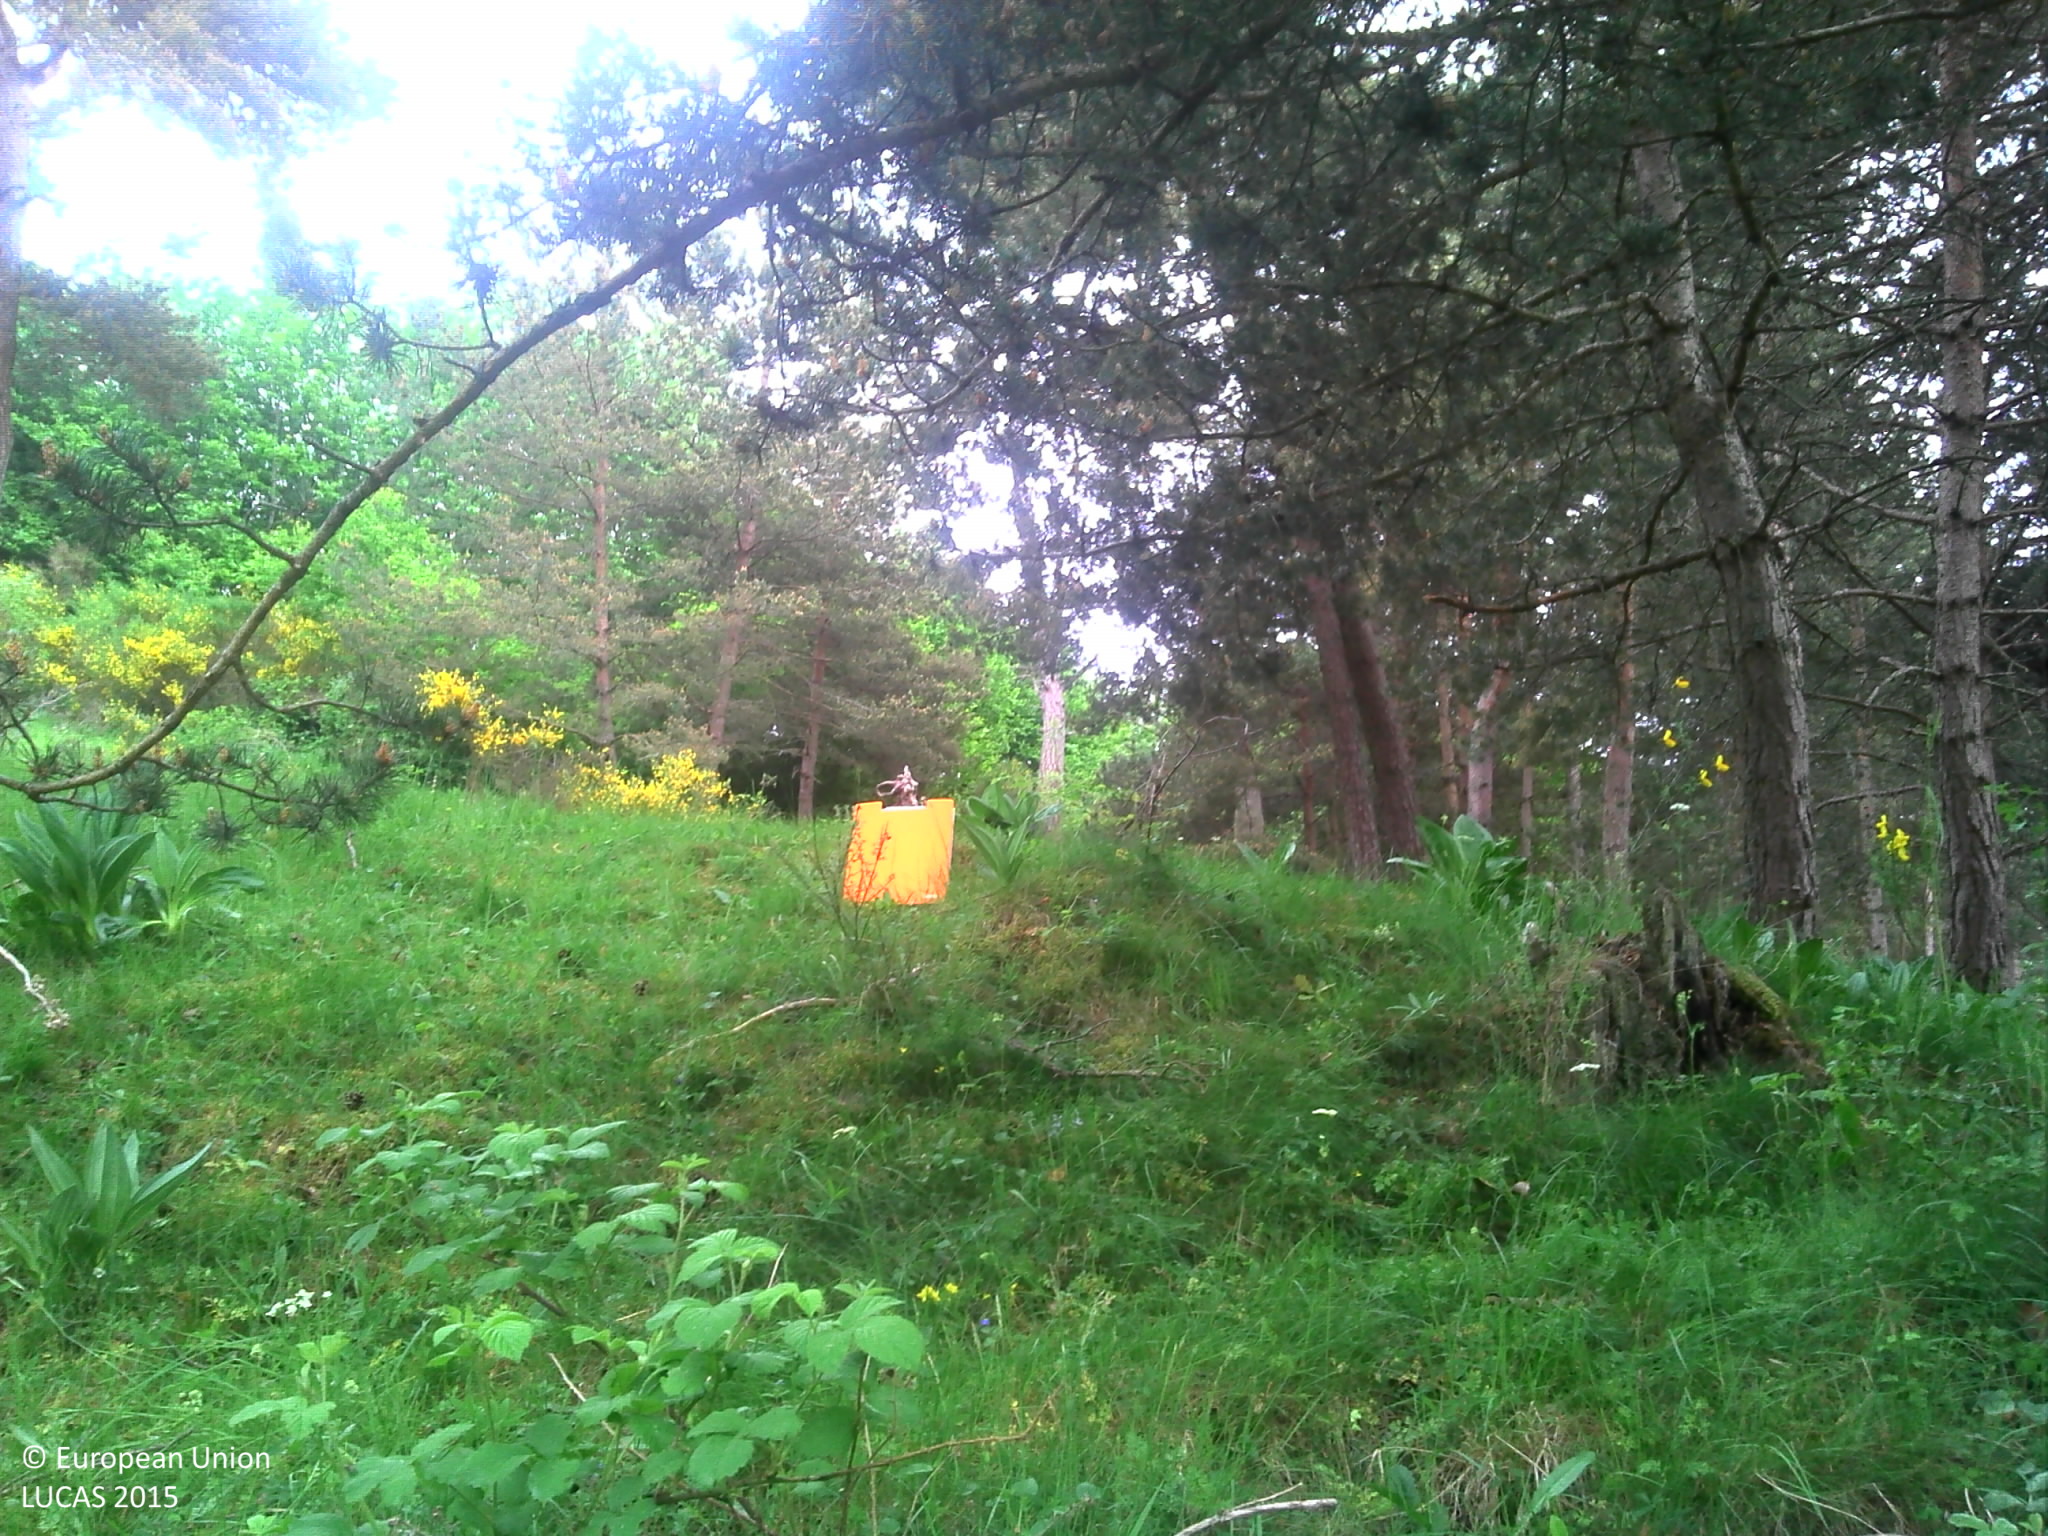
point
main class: Woodland
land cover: Pine dominated mixed woodland
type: alpine coniferous forest
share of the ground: > 75 %
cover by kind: coniferous forest trees 60 %, broadleaved forest trees 20 %, shrubs 10 %, herbaceous plants 10 %
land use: Forestry
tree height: > 5 m
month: June
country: FR
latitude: 45.0164
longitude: 3.2393
